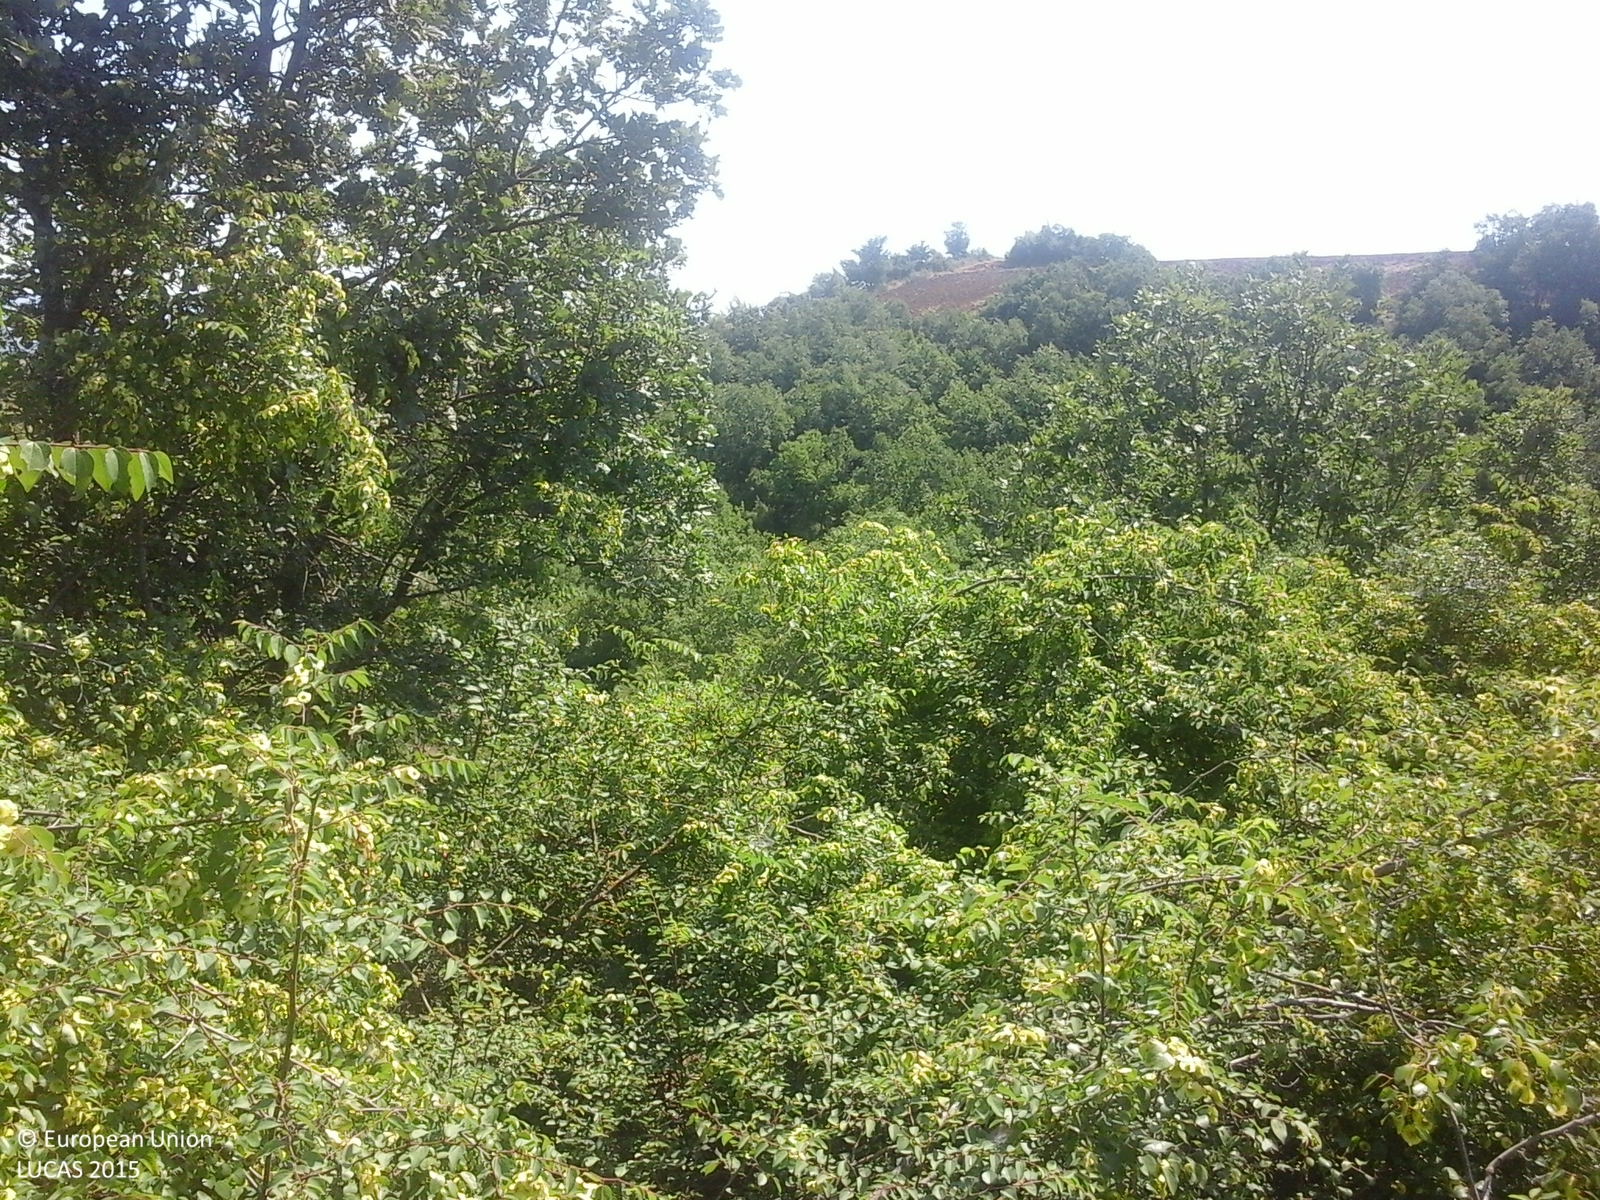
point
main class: Shrubland
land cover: Shrubland without tree cover
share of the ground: > 75 %
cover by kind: shrubs 75 %, herbaceous plants 25 %
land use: Semi-natural and natural areas not in use
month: July
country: GR
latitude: 40.6171
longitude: 23.1895
